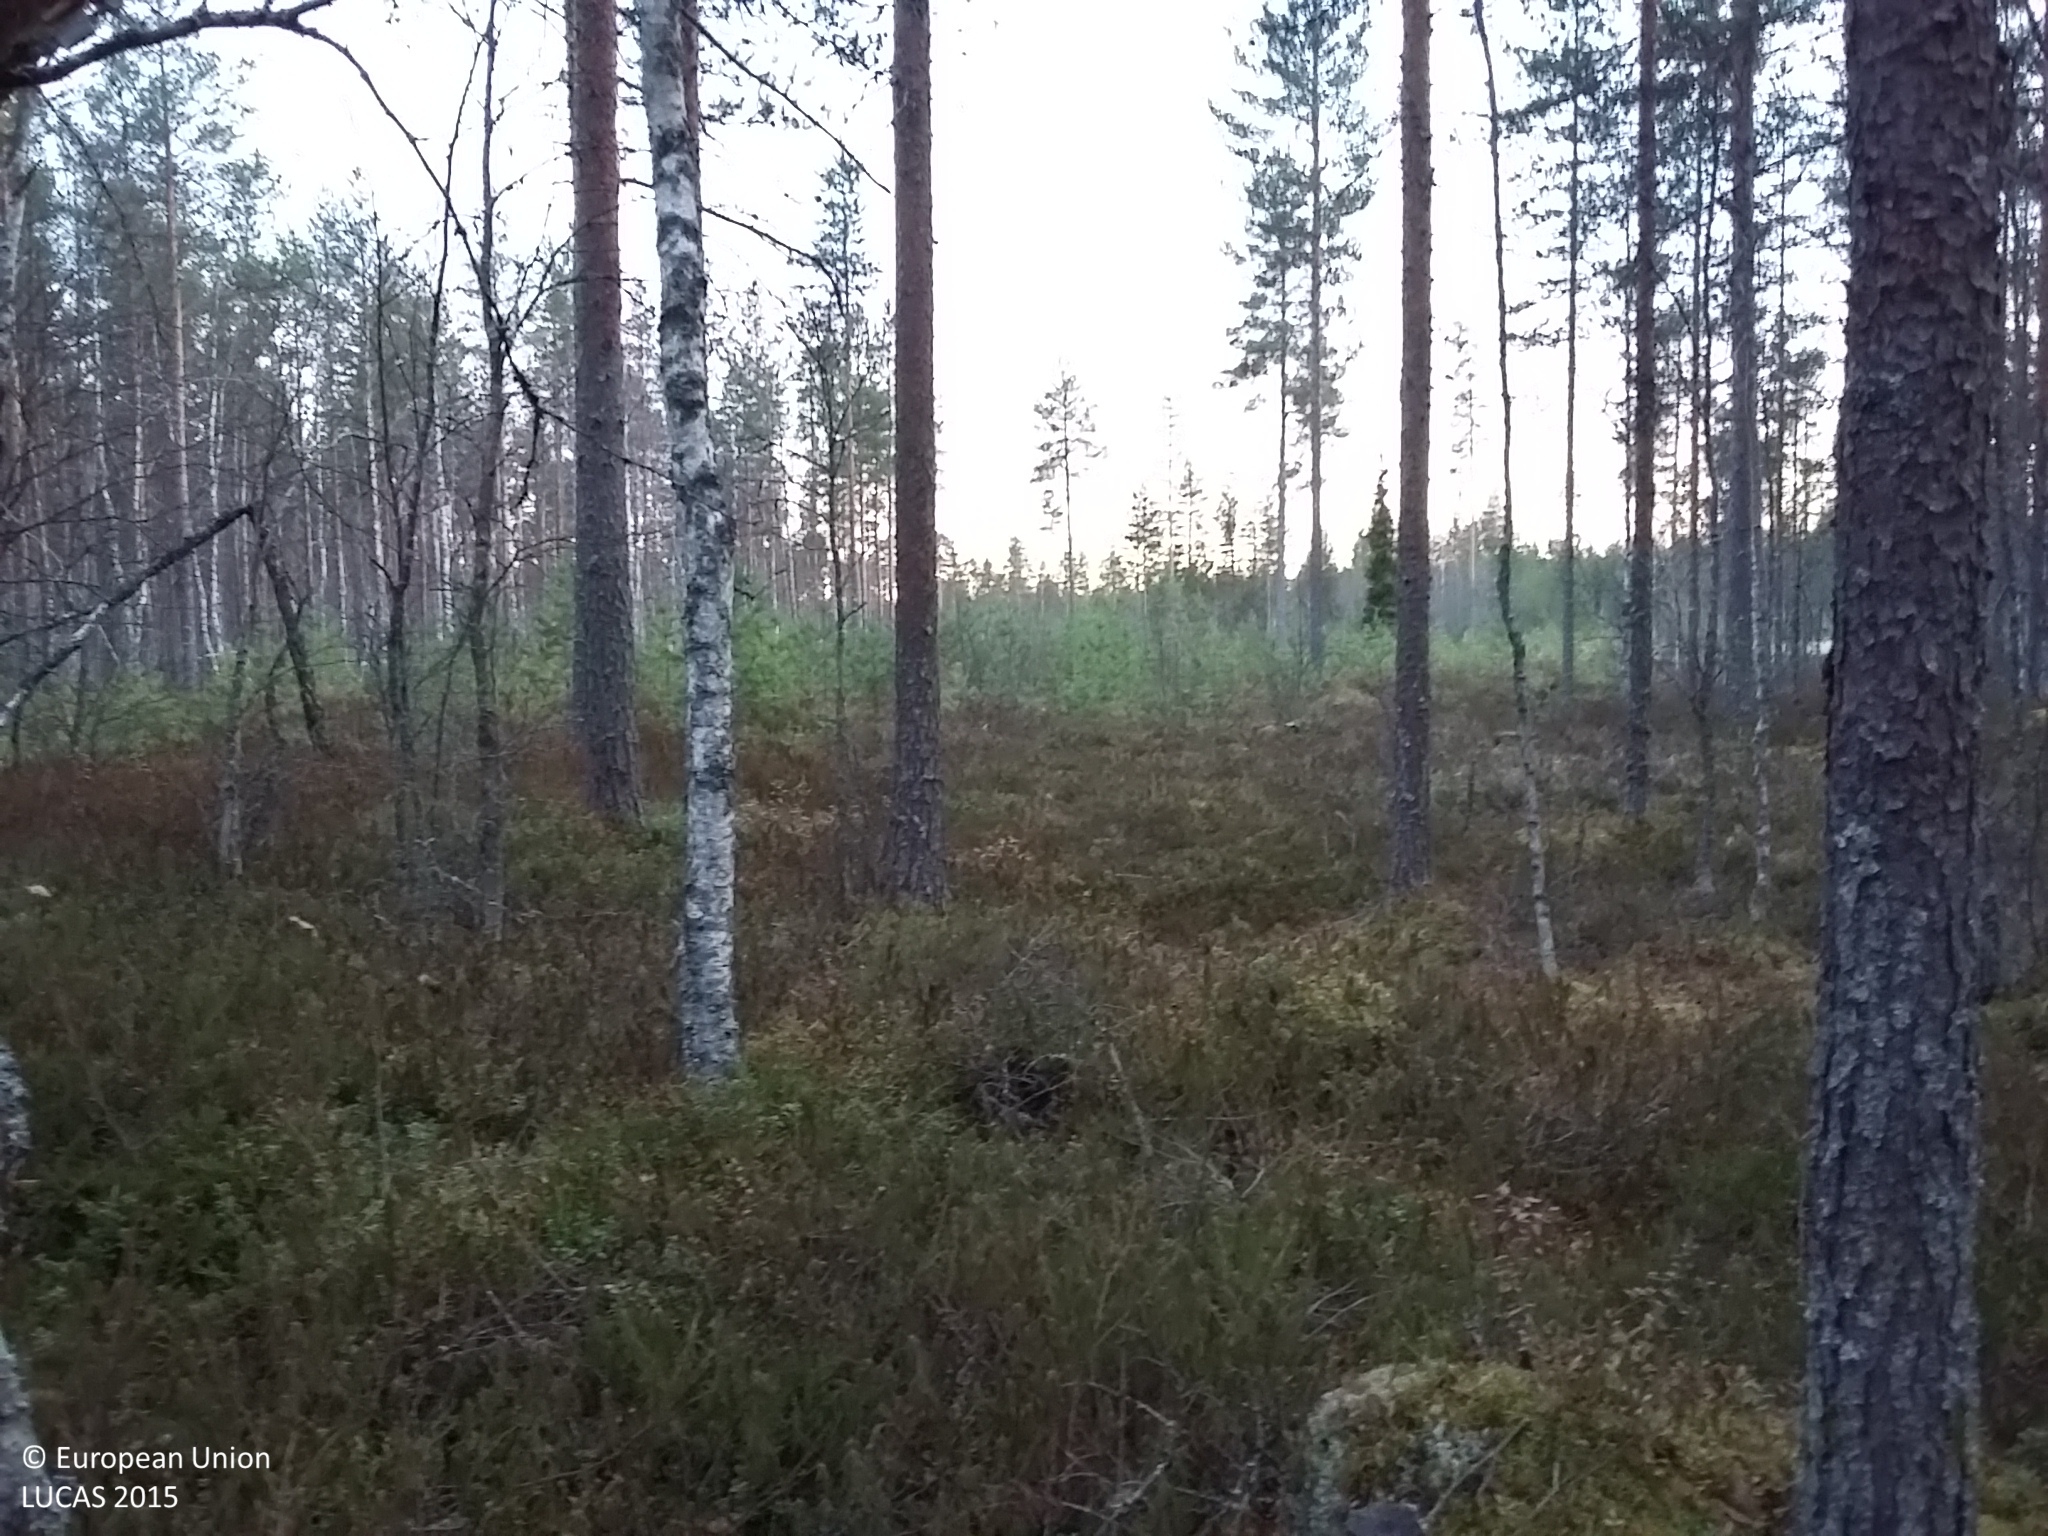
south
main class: Woodland
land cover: Pine dominated coniferous woodland
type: boreal forest
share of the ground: > 75 %
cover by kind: coniferous forest trees 75 %, shrubs 10 %, lichens and mosses 10 %, herbaceous plants 5 %
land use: Forestry
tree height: > 5 m
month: October
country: FI
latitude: 64.0647
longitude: 25.0241
